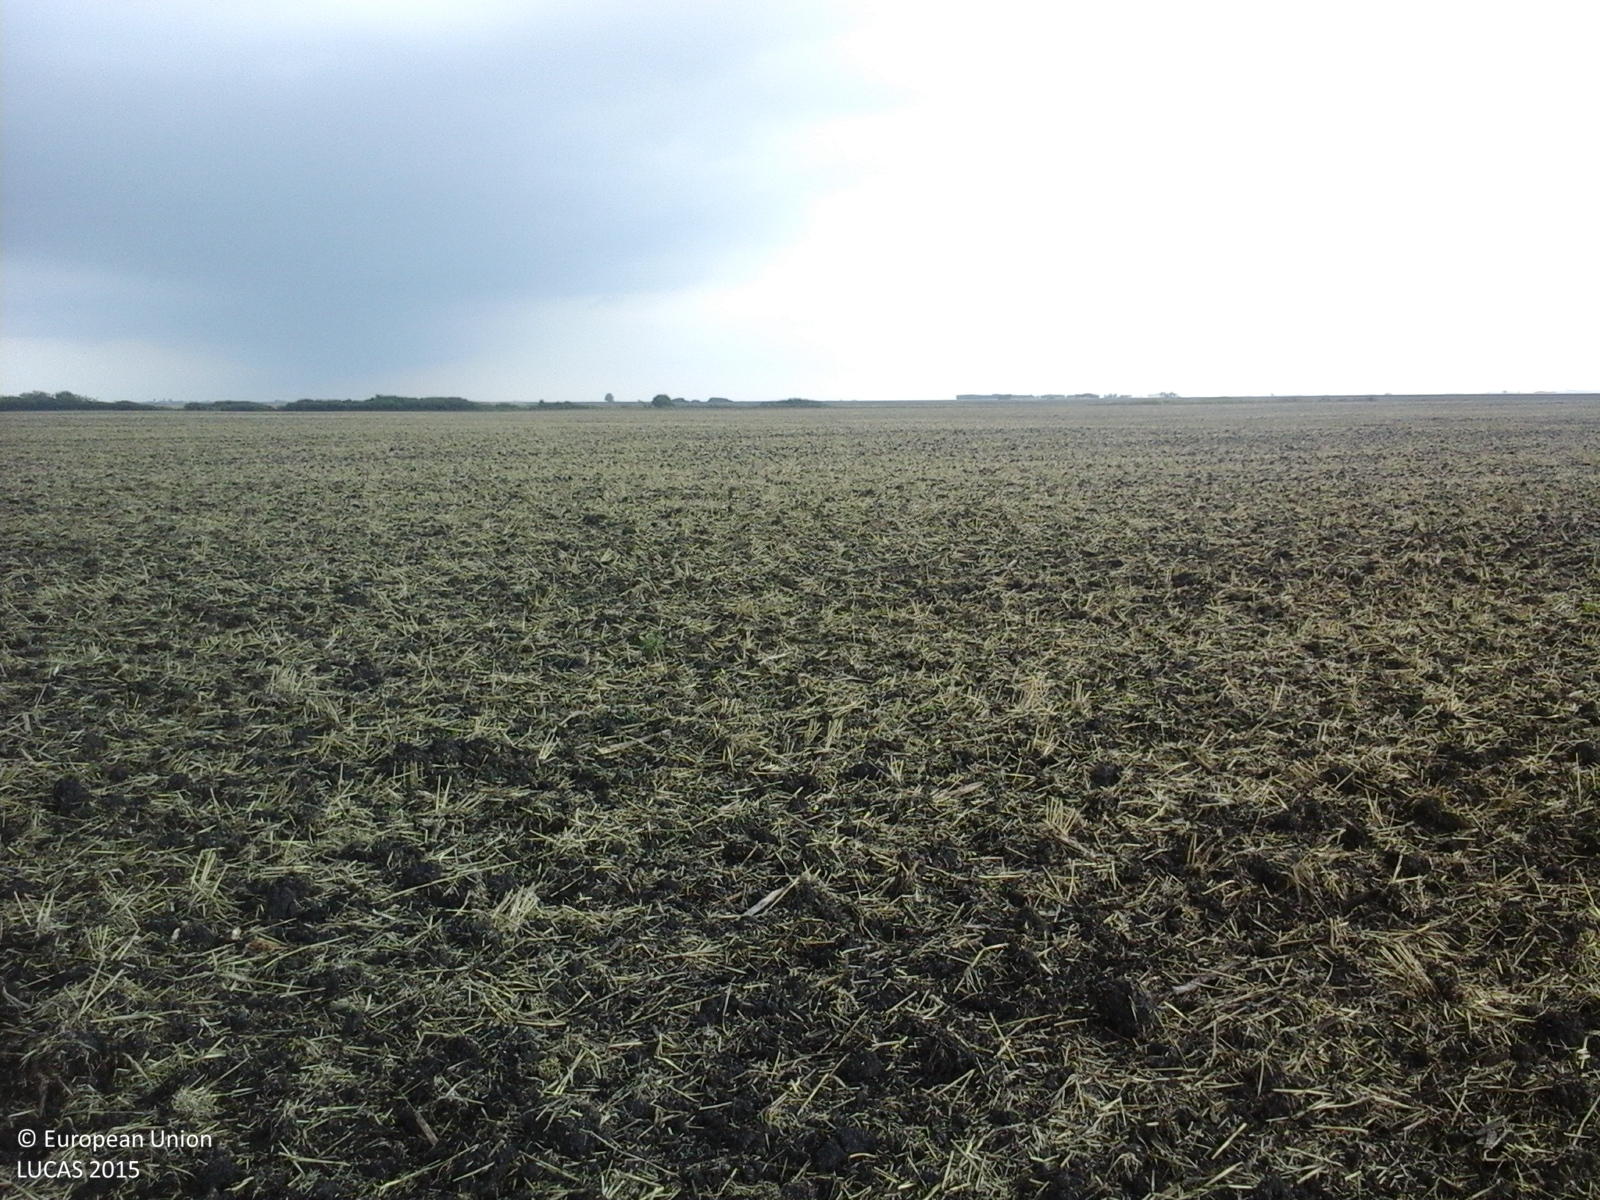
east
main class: Cropland
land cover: Common wheat
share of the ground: < 10 %
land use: Agriculture (excluding fallow land and kitchen gardens)
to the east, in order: Common wheat
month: August
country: RO
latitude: 46.0857
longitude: 20.3300
